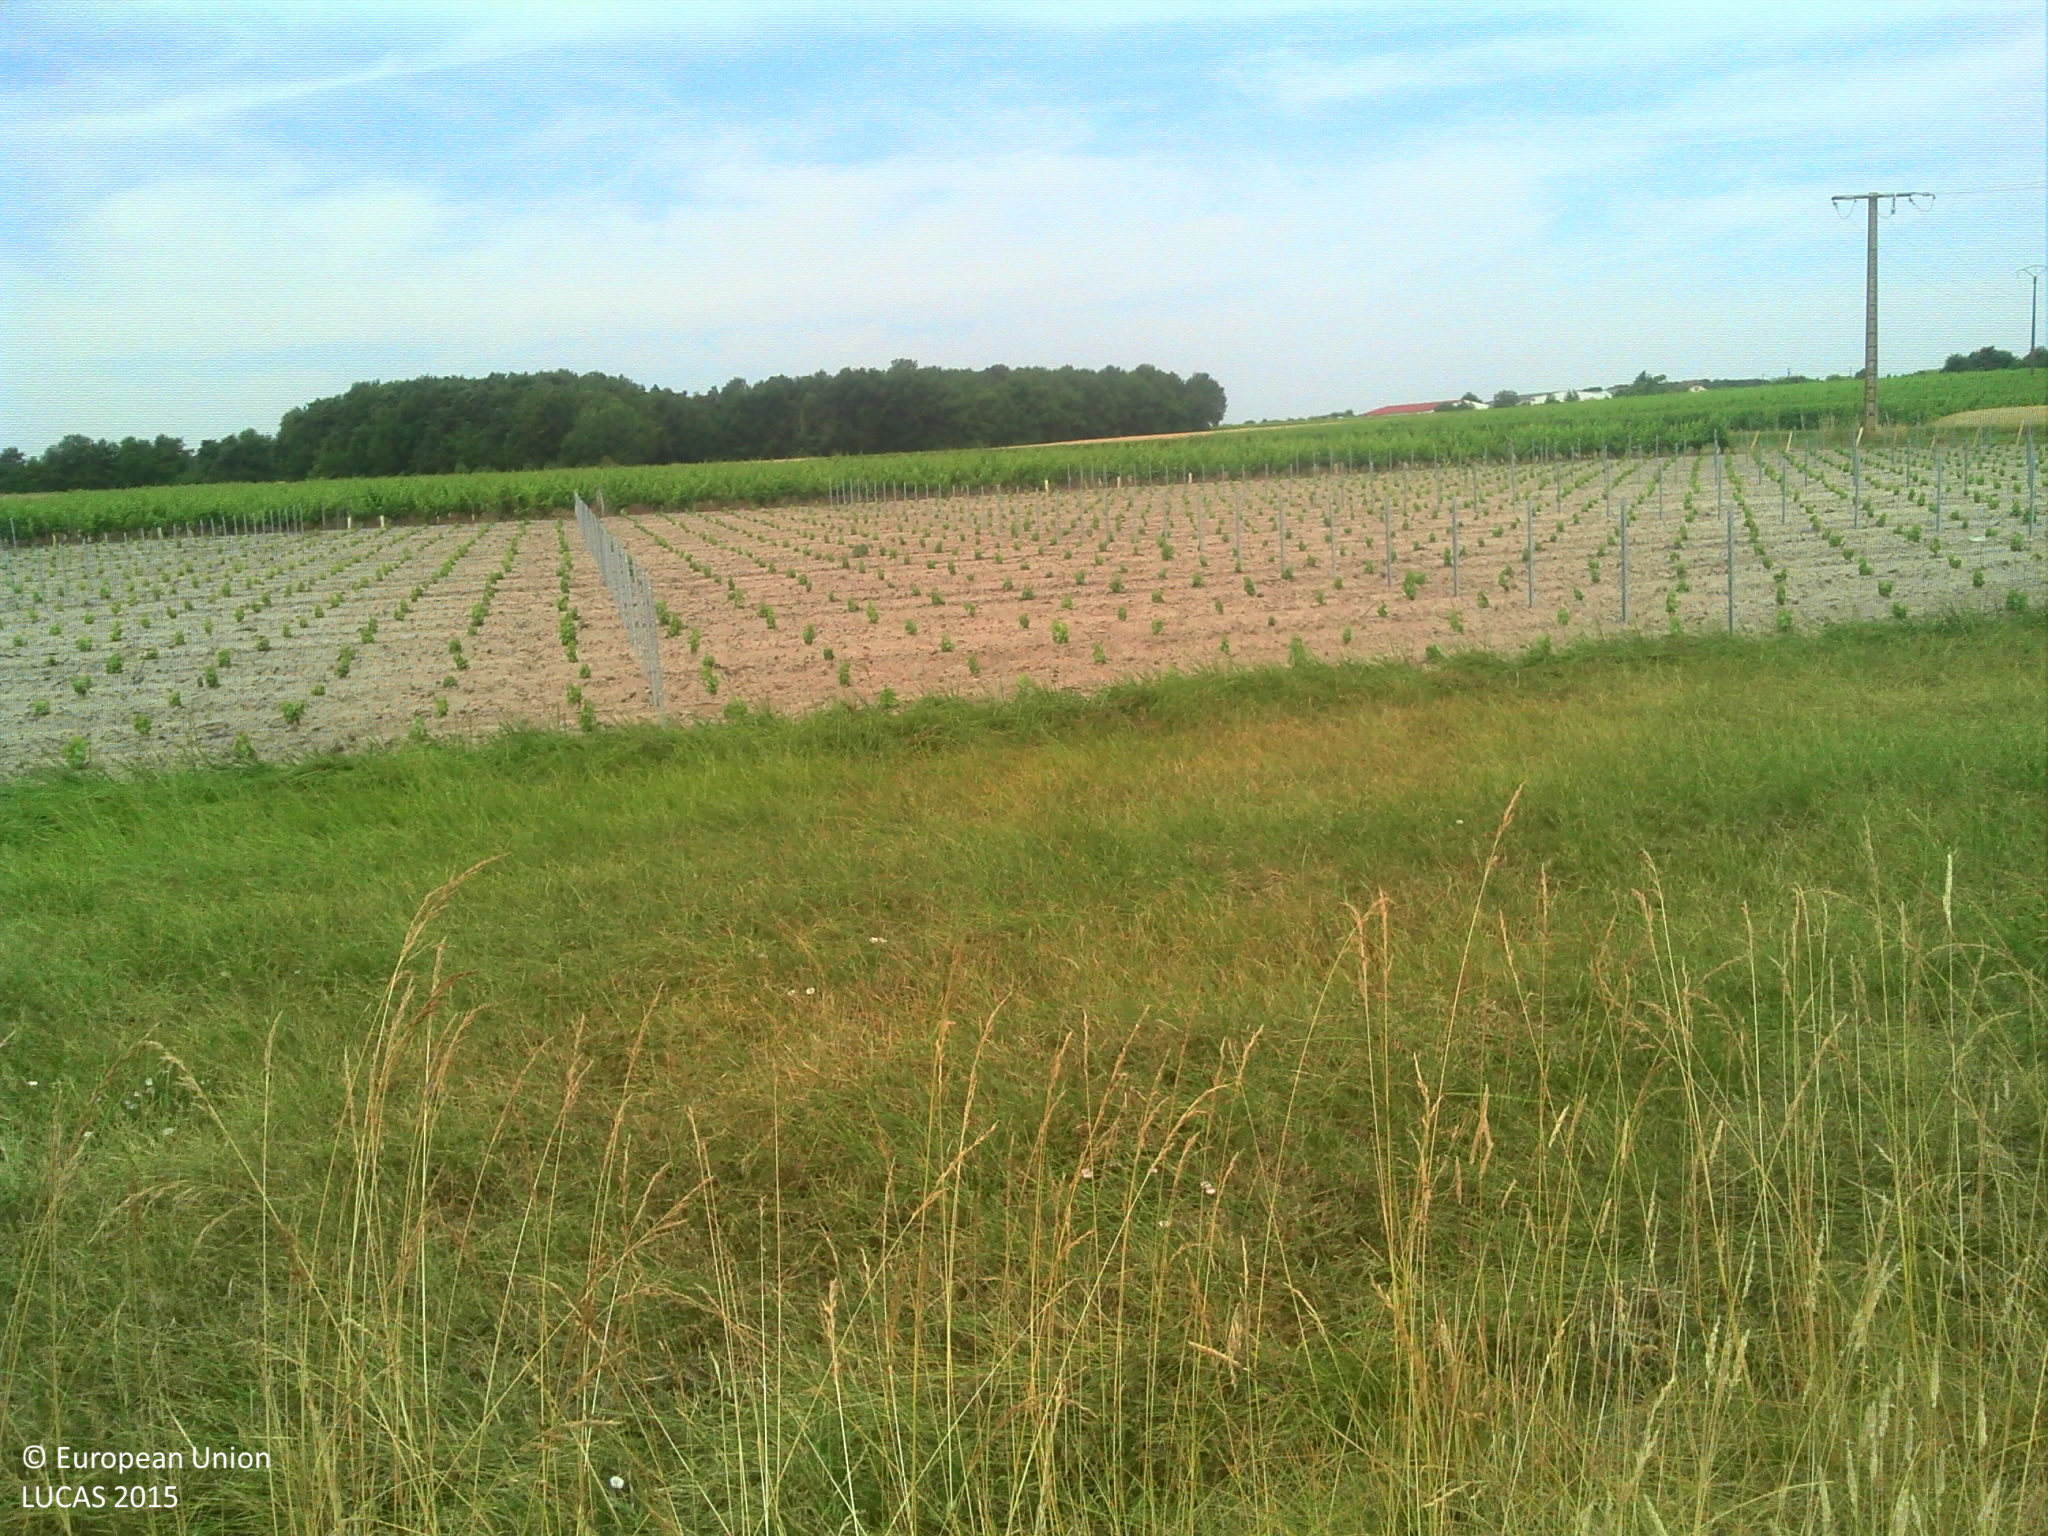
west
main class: Grassland
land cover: Grassland without tree/shrub cover
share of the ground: > 75 %
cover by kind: herbaceous plants 100 %
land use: Agriculture (excluding fallow land and kitchen gardens)
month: June
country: FR
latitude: 47.3616
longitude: 1.3928
